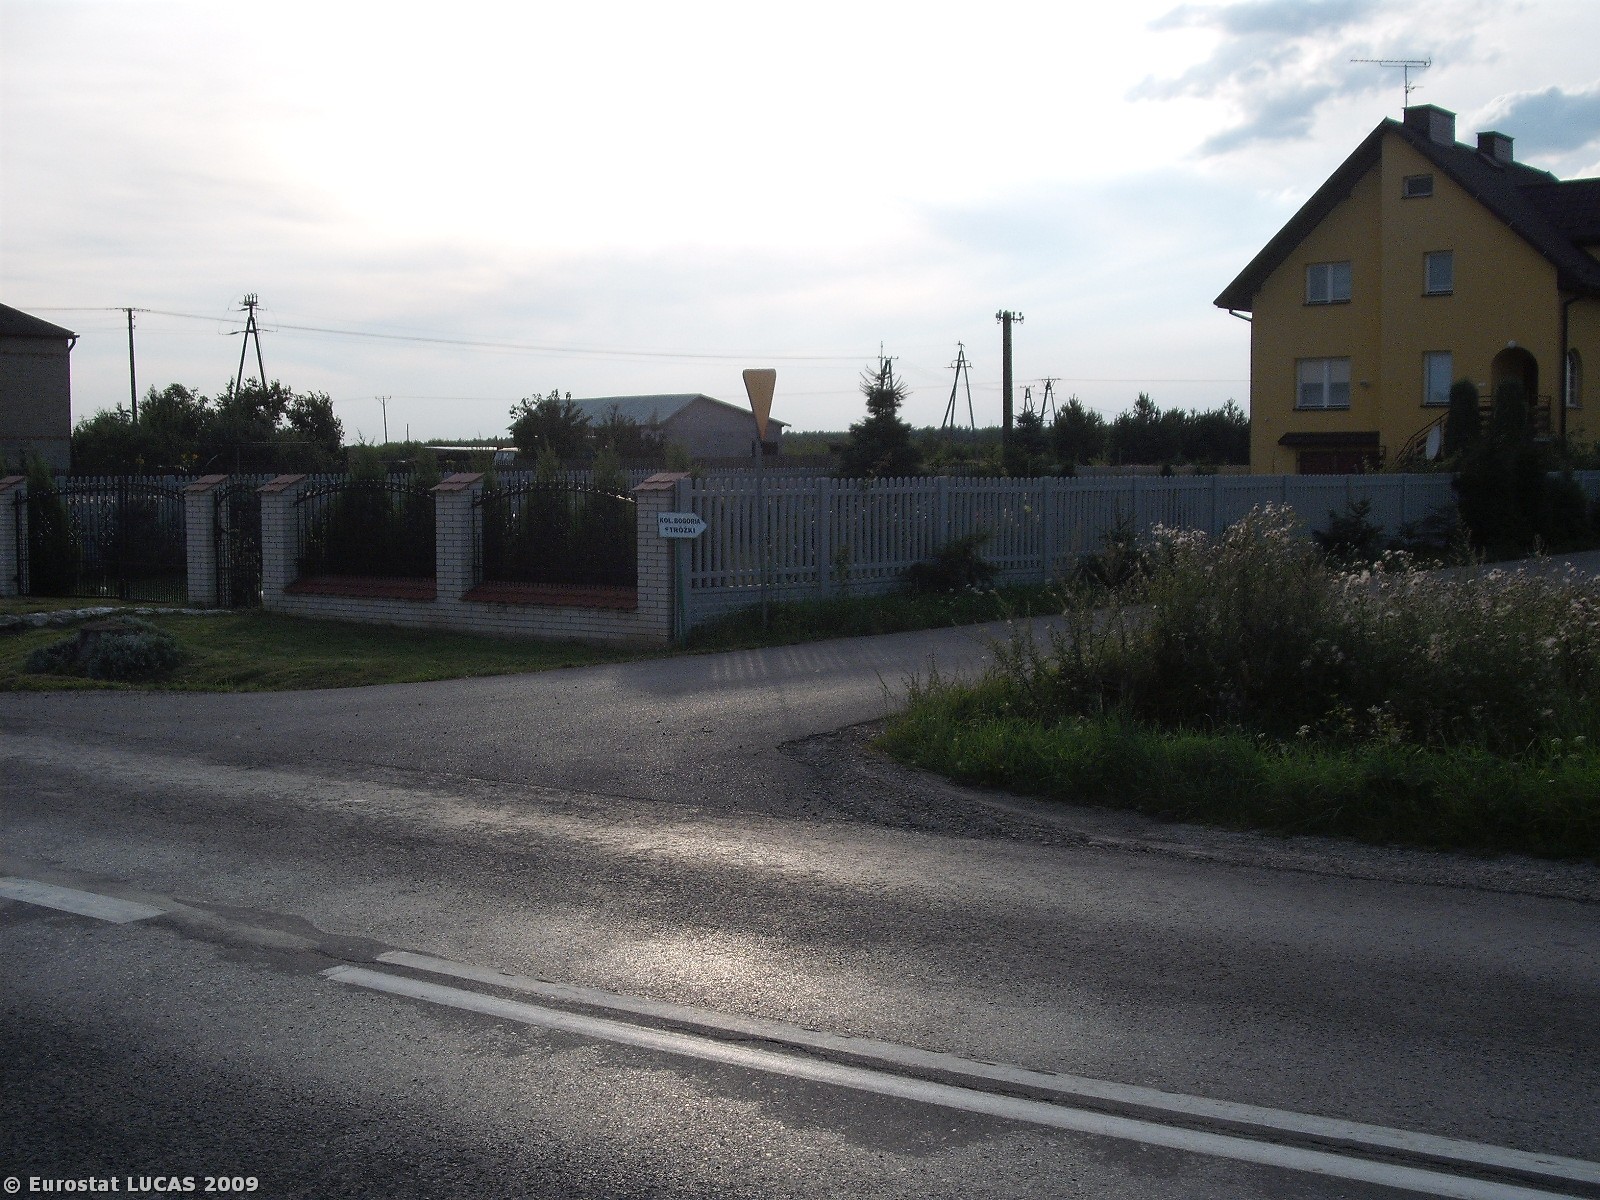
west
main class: Grassland
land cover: Grassland without tree/shrub cover
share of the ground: > 75 %
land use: Residential
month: July
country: PL
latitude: 50.6263
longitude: 21.2288
